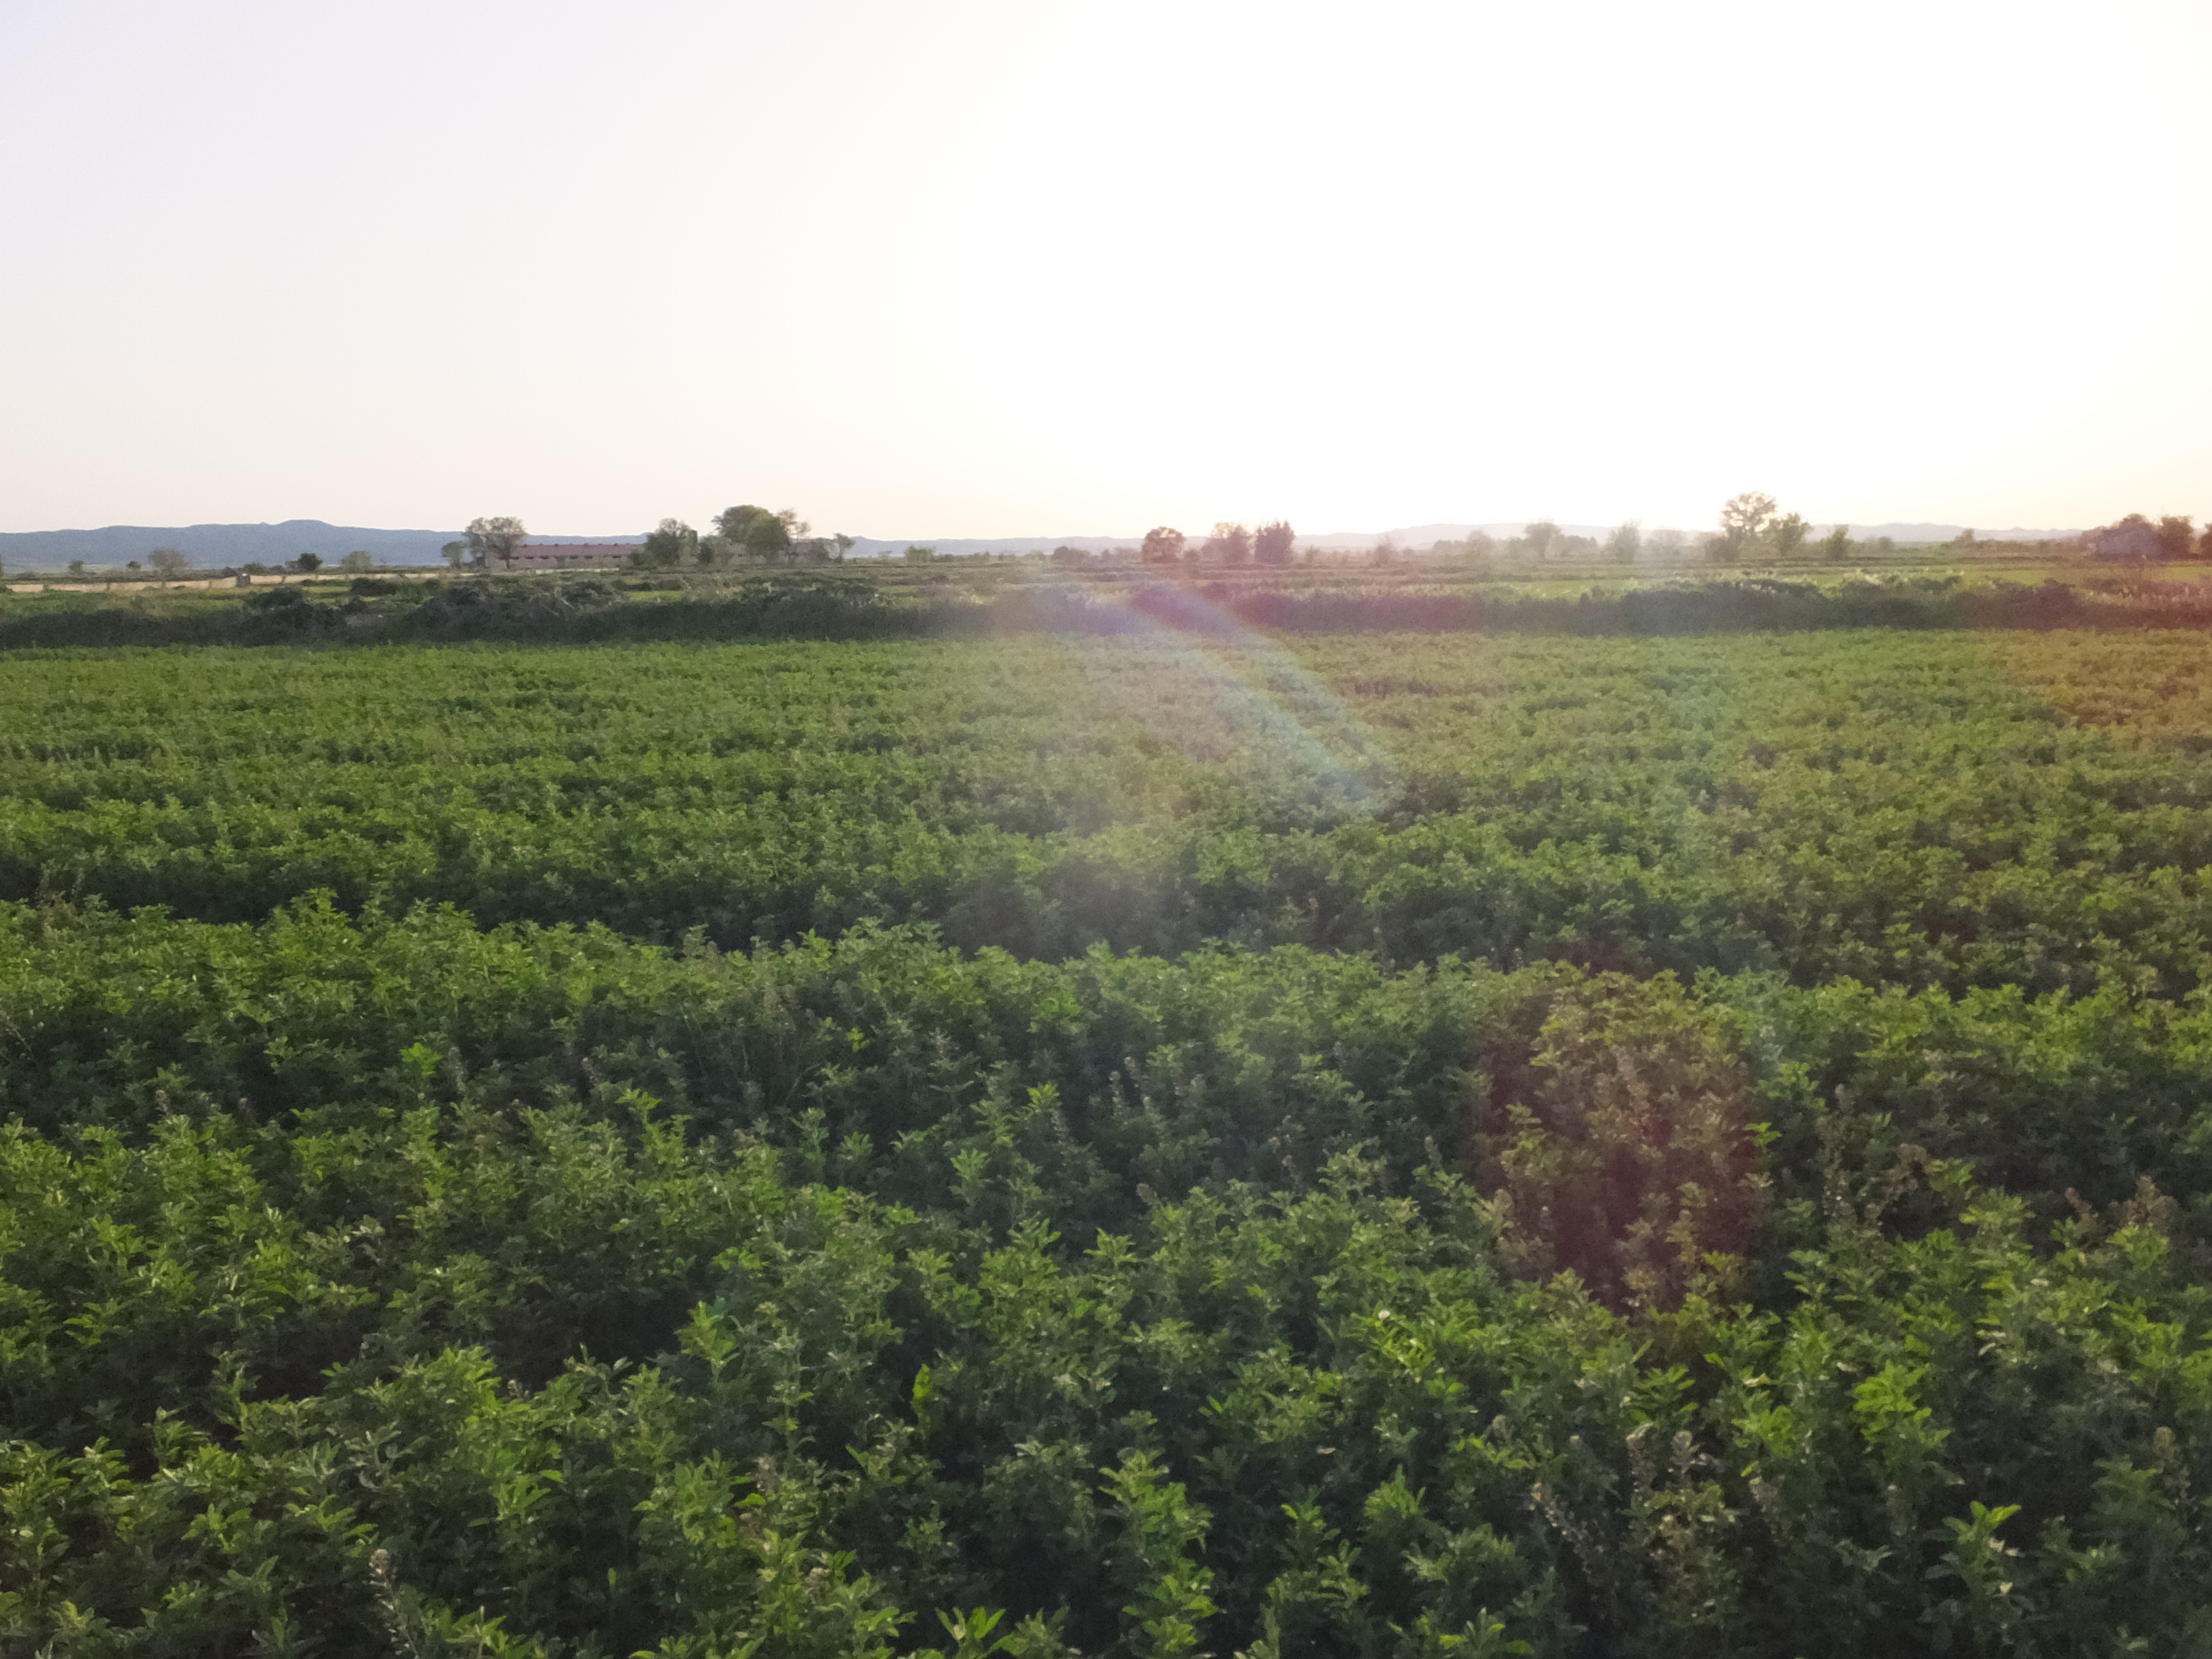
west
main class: Cropland
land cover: Lucerne
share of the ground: > 75 %
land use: Agriculture (excluding fallow land and kitchen gardens)
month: April
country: ES
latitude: 41.7966
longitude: -0.3328
